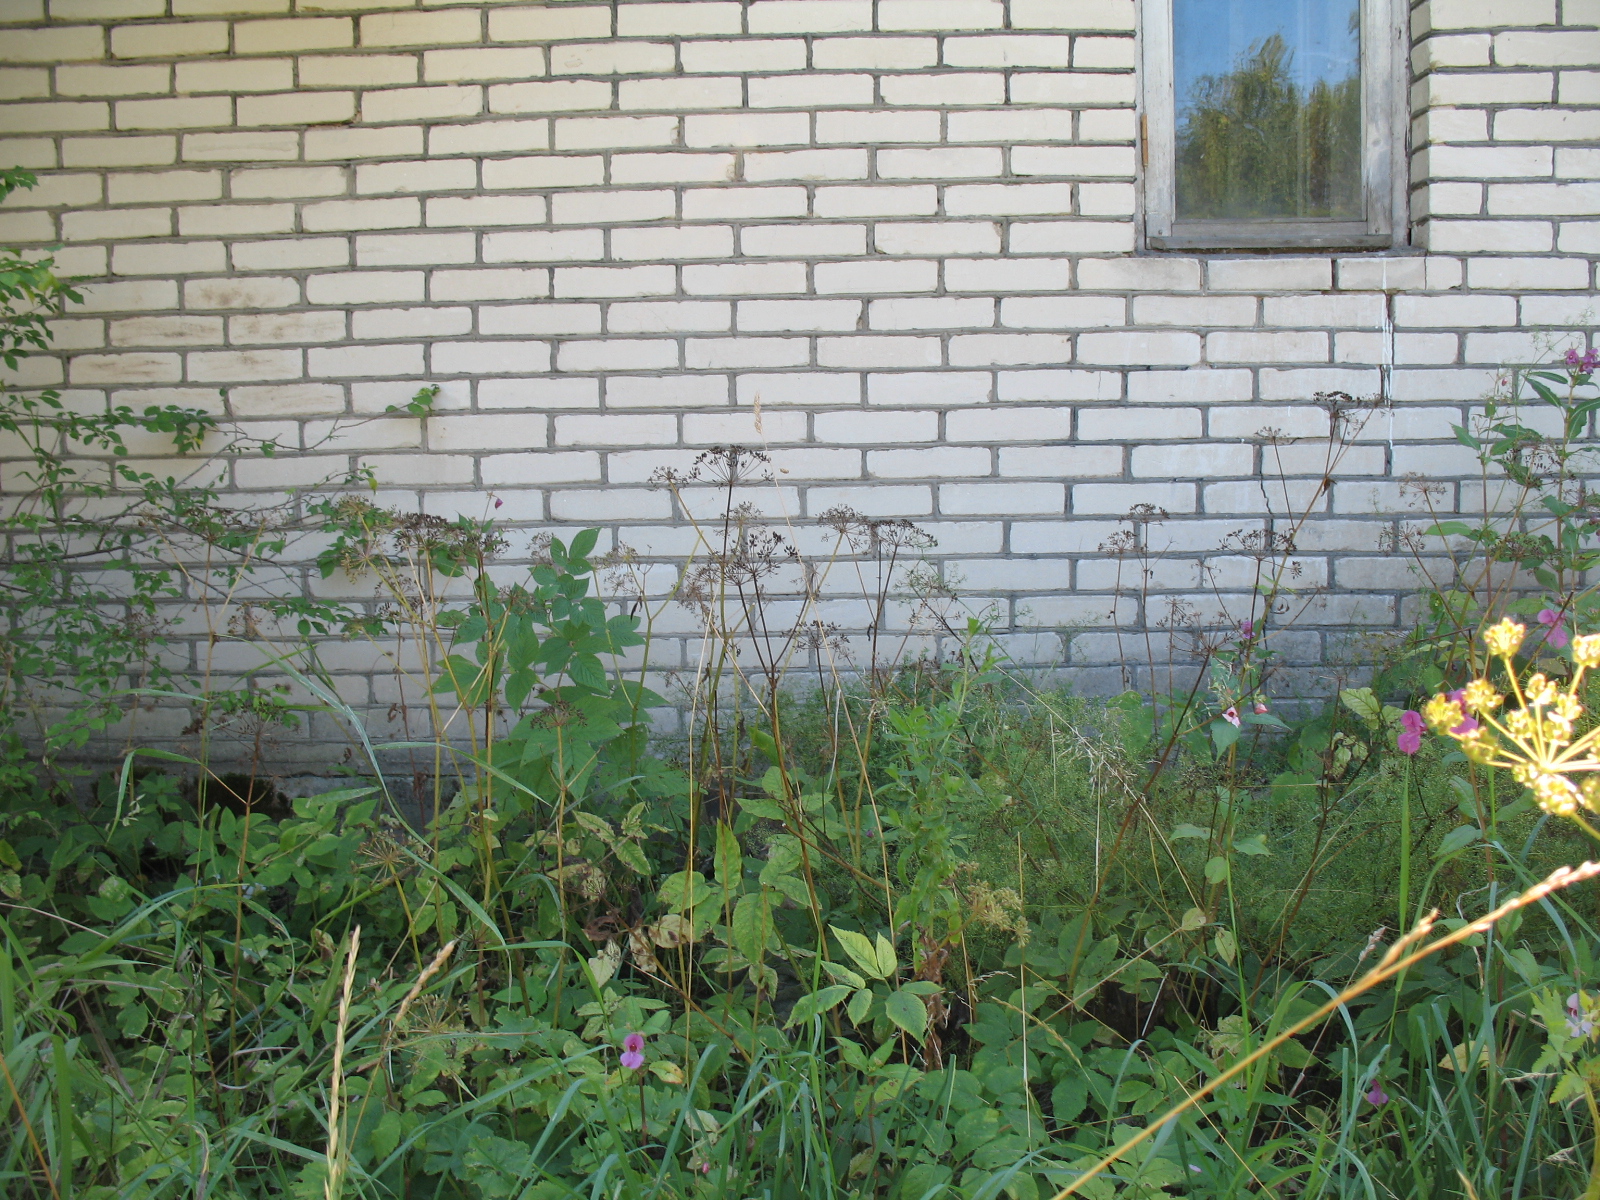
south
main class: Grassland
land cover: Grassland without tree/shrub cover
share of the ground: > 75 %
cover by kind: herbaceous plants 100 %
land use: Residential
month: August
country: LV
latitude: 56.5265
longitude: 25.6157
